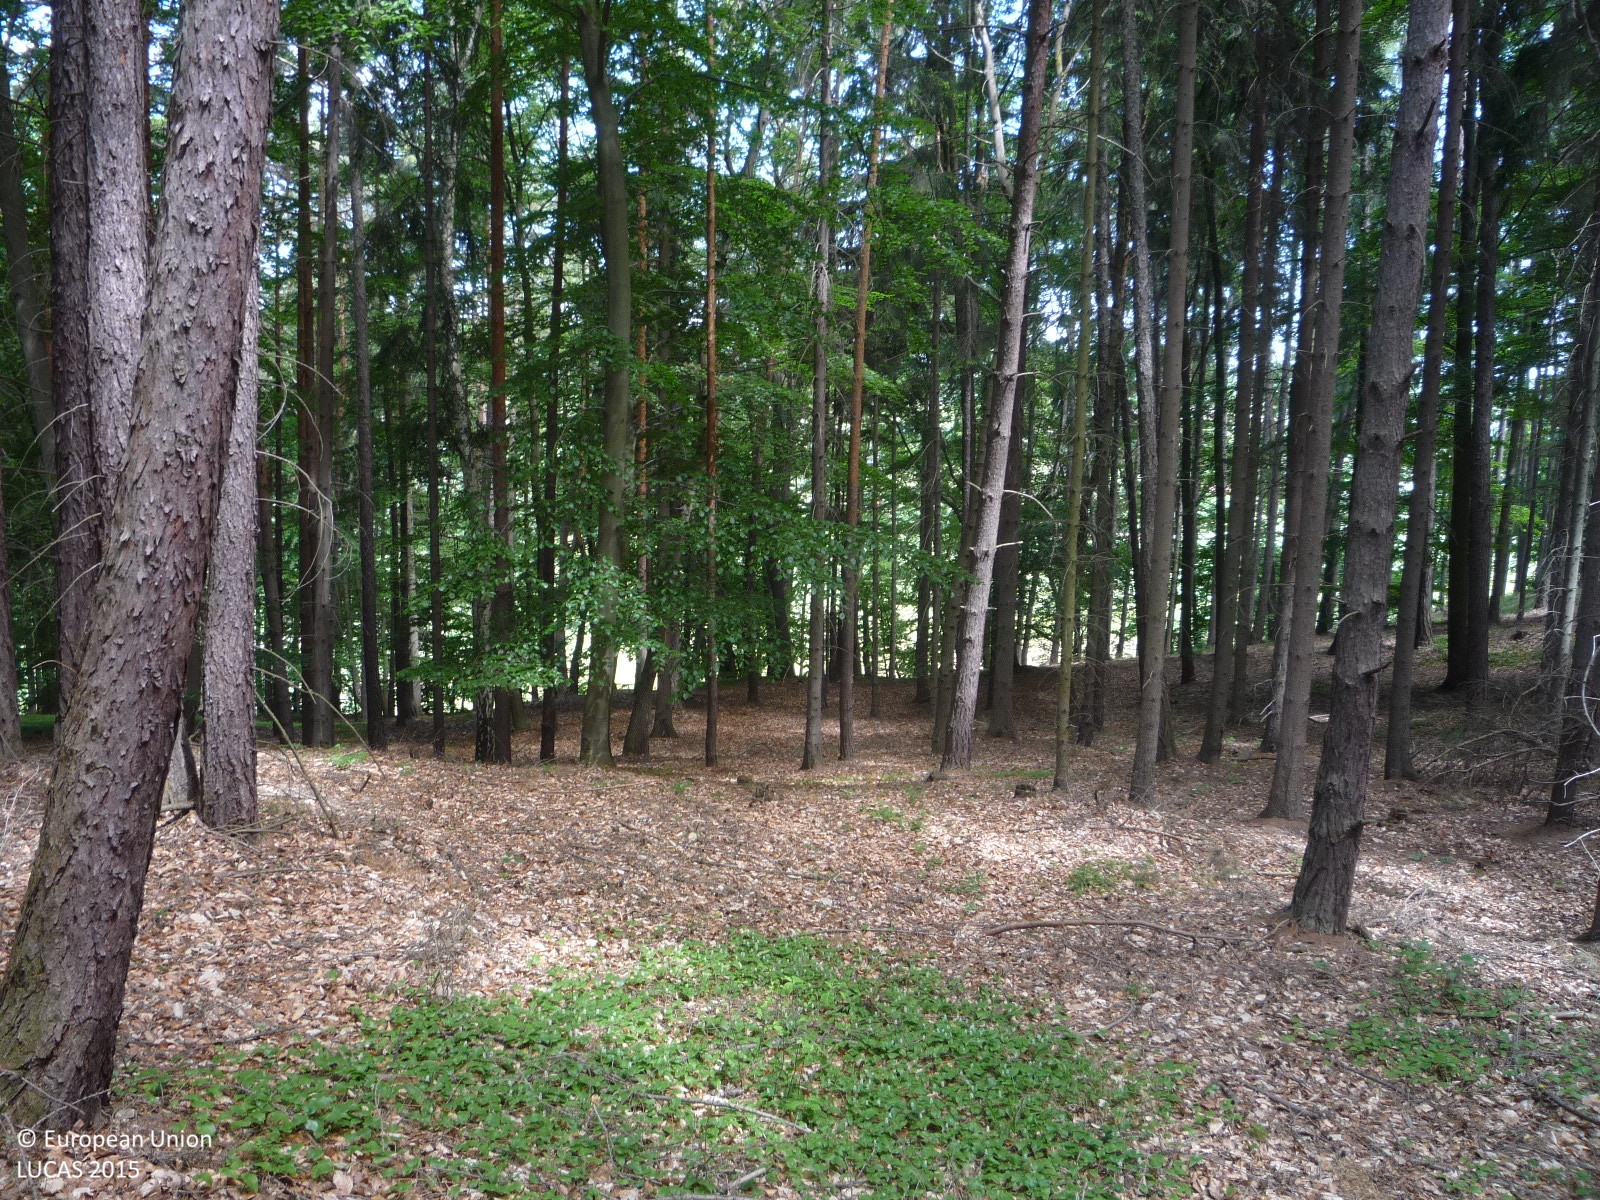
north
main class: Woodland
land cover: Other mixed woodland
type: hemiboreal forest and nemoral coniferous forest and mixed broadleaved-coniferous forest
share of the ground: > 75 %
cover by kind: coniferous forest trees 60 %, broadleaved forest trees 30 %, herbaceous plants 5 %, unconsolidated bare surface 5 %
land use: Forestry
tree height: > 5 m
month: June
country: CZ
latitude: 50.2092
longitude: 13.8541
